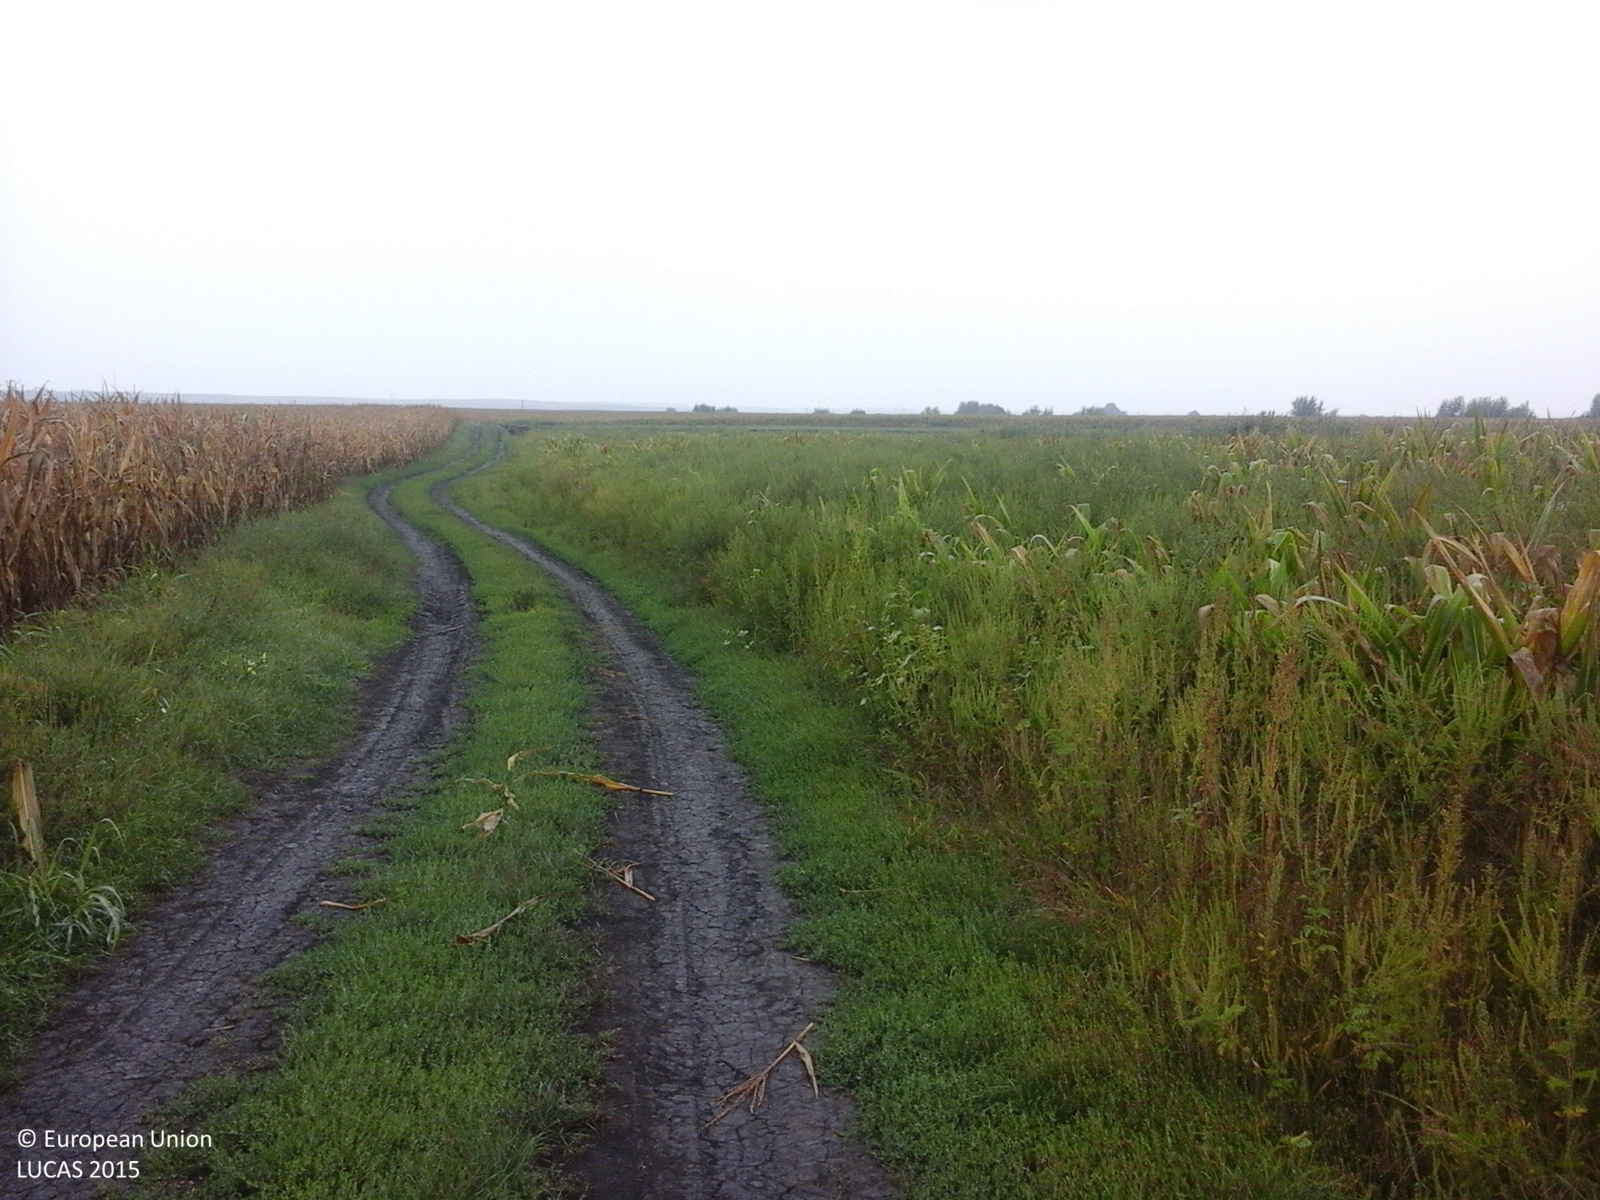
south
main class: Cropland
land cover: Maize
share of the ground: > 75 %
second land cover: Spontaneously vegetated surfaces
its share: > 75 %
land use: Agriculture (excluding fallow land and kitchen gardens)
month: September
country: RO
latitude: 47.4090
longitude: 22.0969
